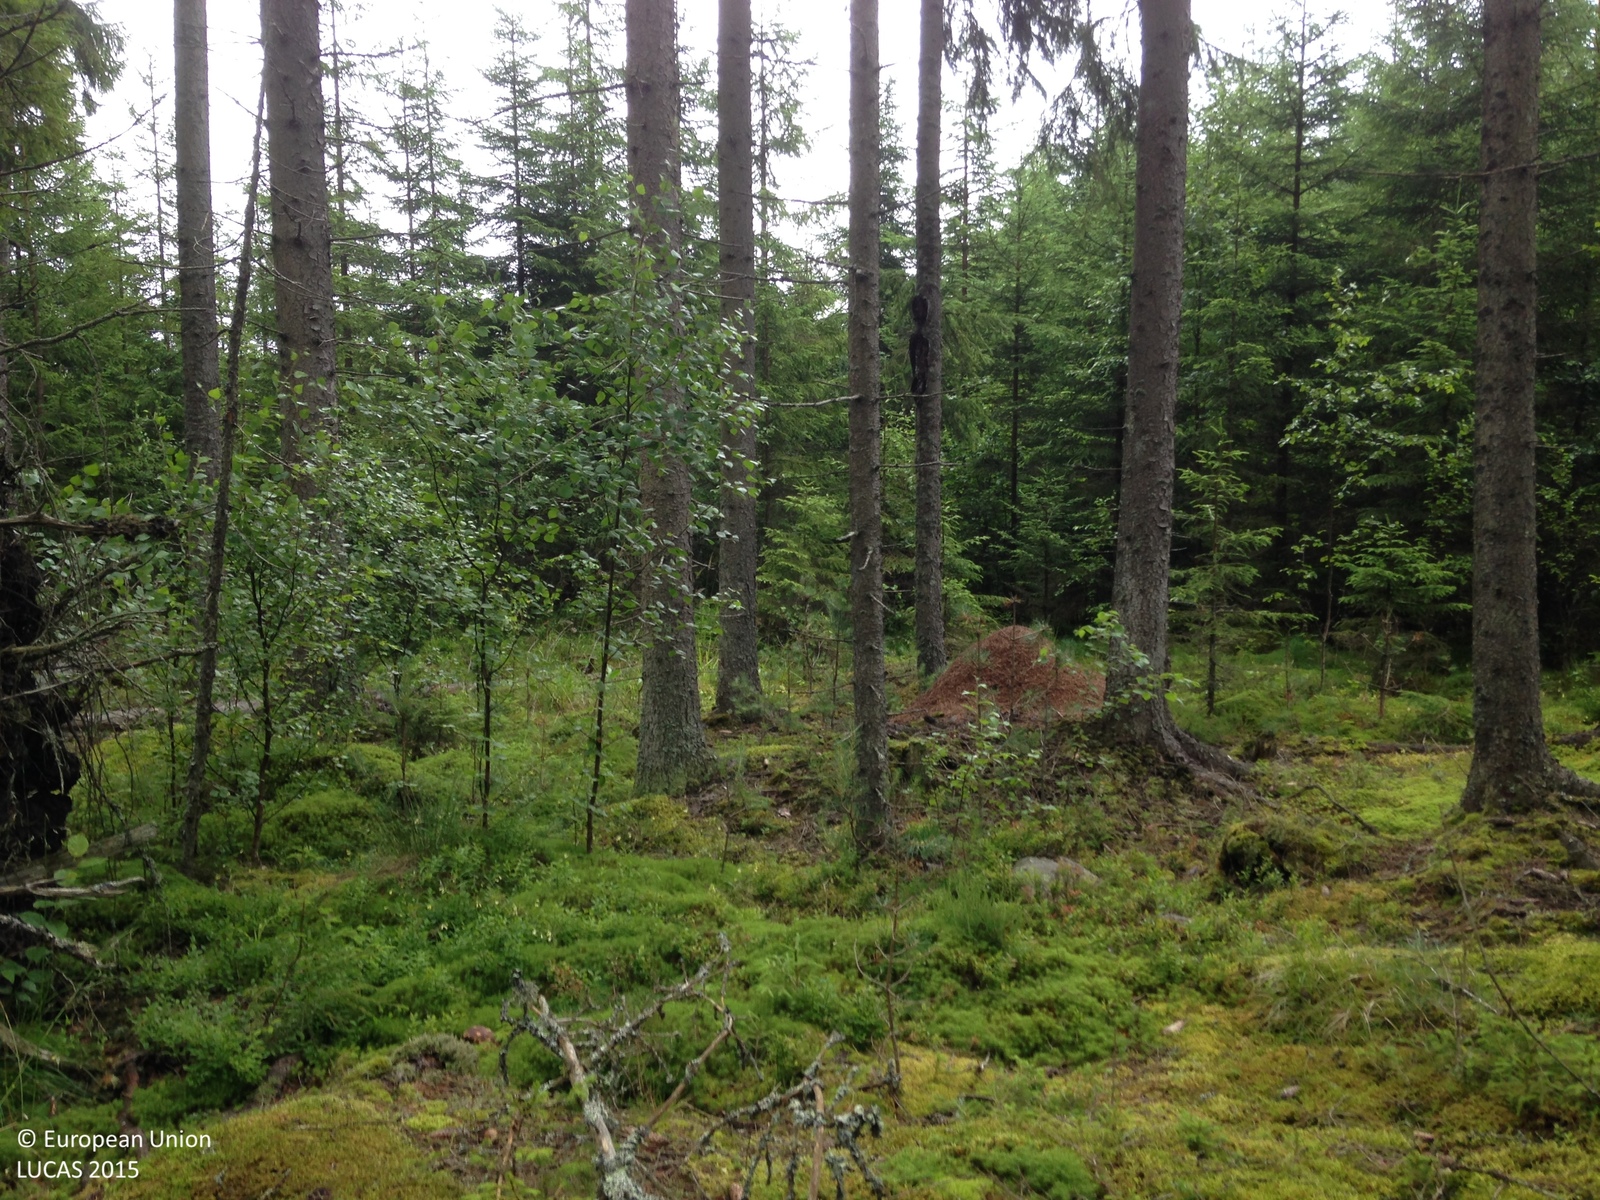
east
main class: Woodland
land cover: Spruce dominated coniferous woodland
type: boreal forest
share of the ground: 25 - 50 %
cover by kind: coniferous forest trees 35 %, herbaceous plants 30 %, lichens and mosses 20 %, shrubs 10 %, broadleaved forest trees 5 %
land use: Forestry
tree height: > 5 m
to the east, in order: Spruce dominated coniferous woodland; Spruce dominated mixed woodland; Spruce dominated coniferous woodland
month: July
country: SE
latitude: 59.0809
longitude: 14.5112
